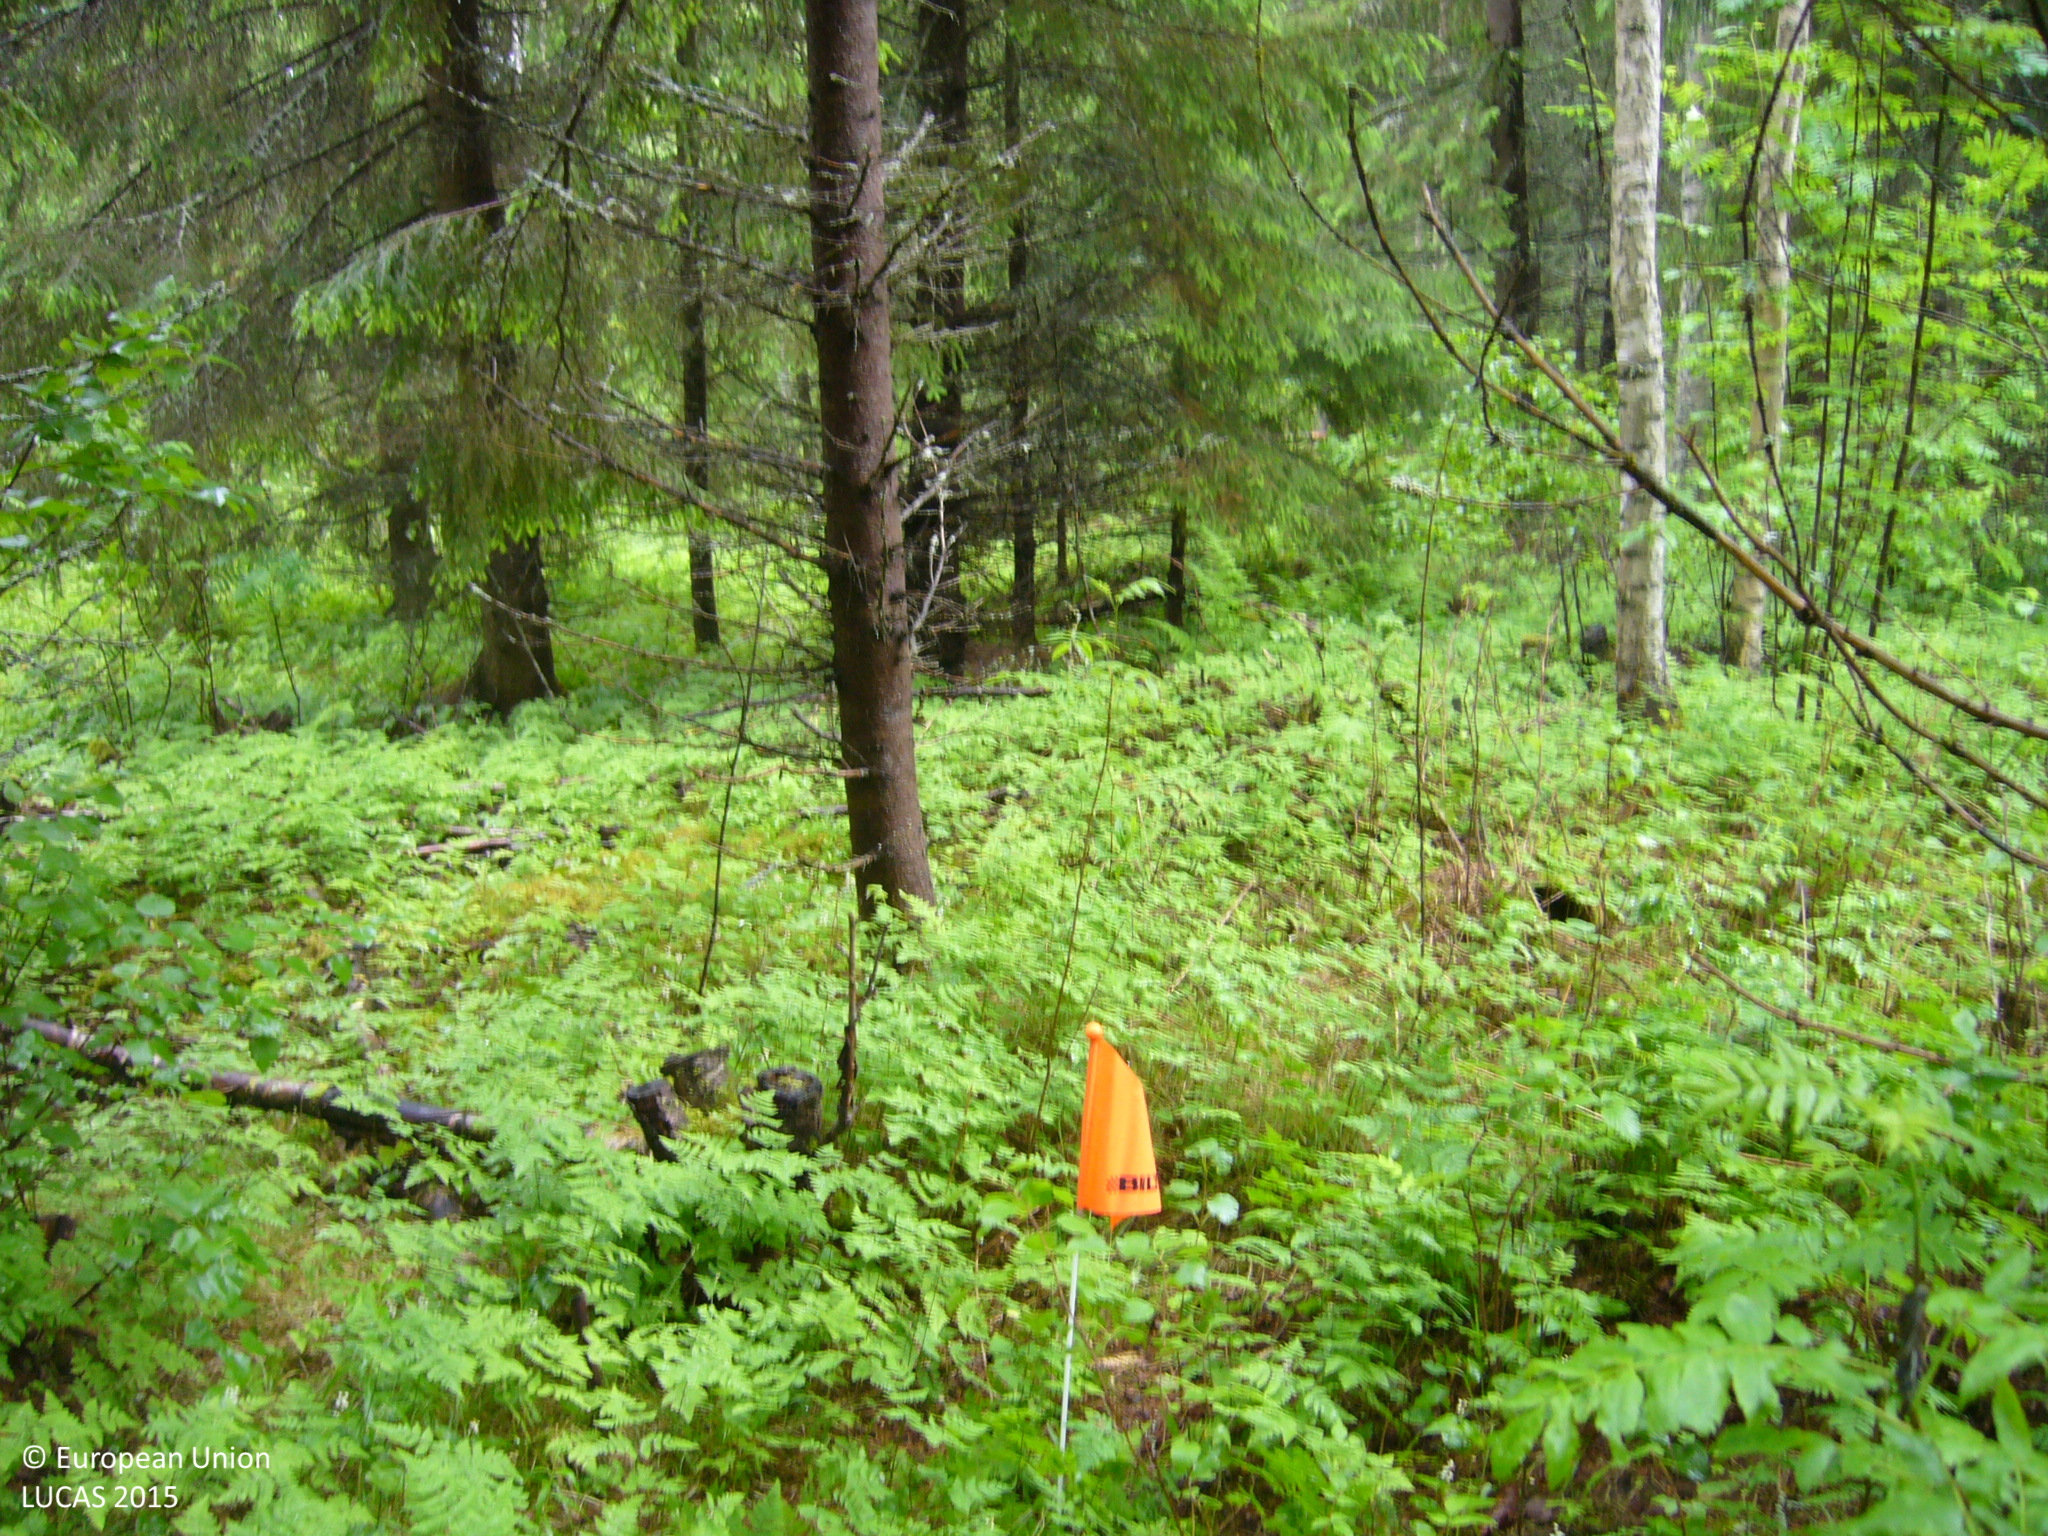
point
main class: Woodland
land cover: Spruce dominated mixed woodland
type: boreal forest
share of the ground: > 75 %
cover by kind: coniferous forest trees 55 %, broadleaved forest trees 25 %, shrubs 20 %
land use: Forestry
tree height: > 5 m
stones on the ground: < 10 %
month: June
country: FI
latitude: 63.6501
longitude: 26.5437
